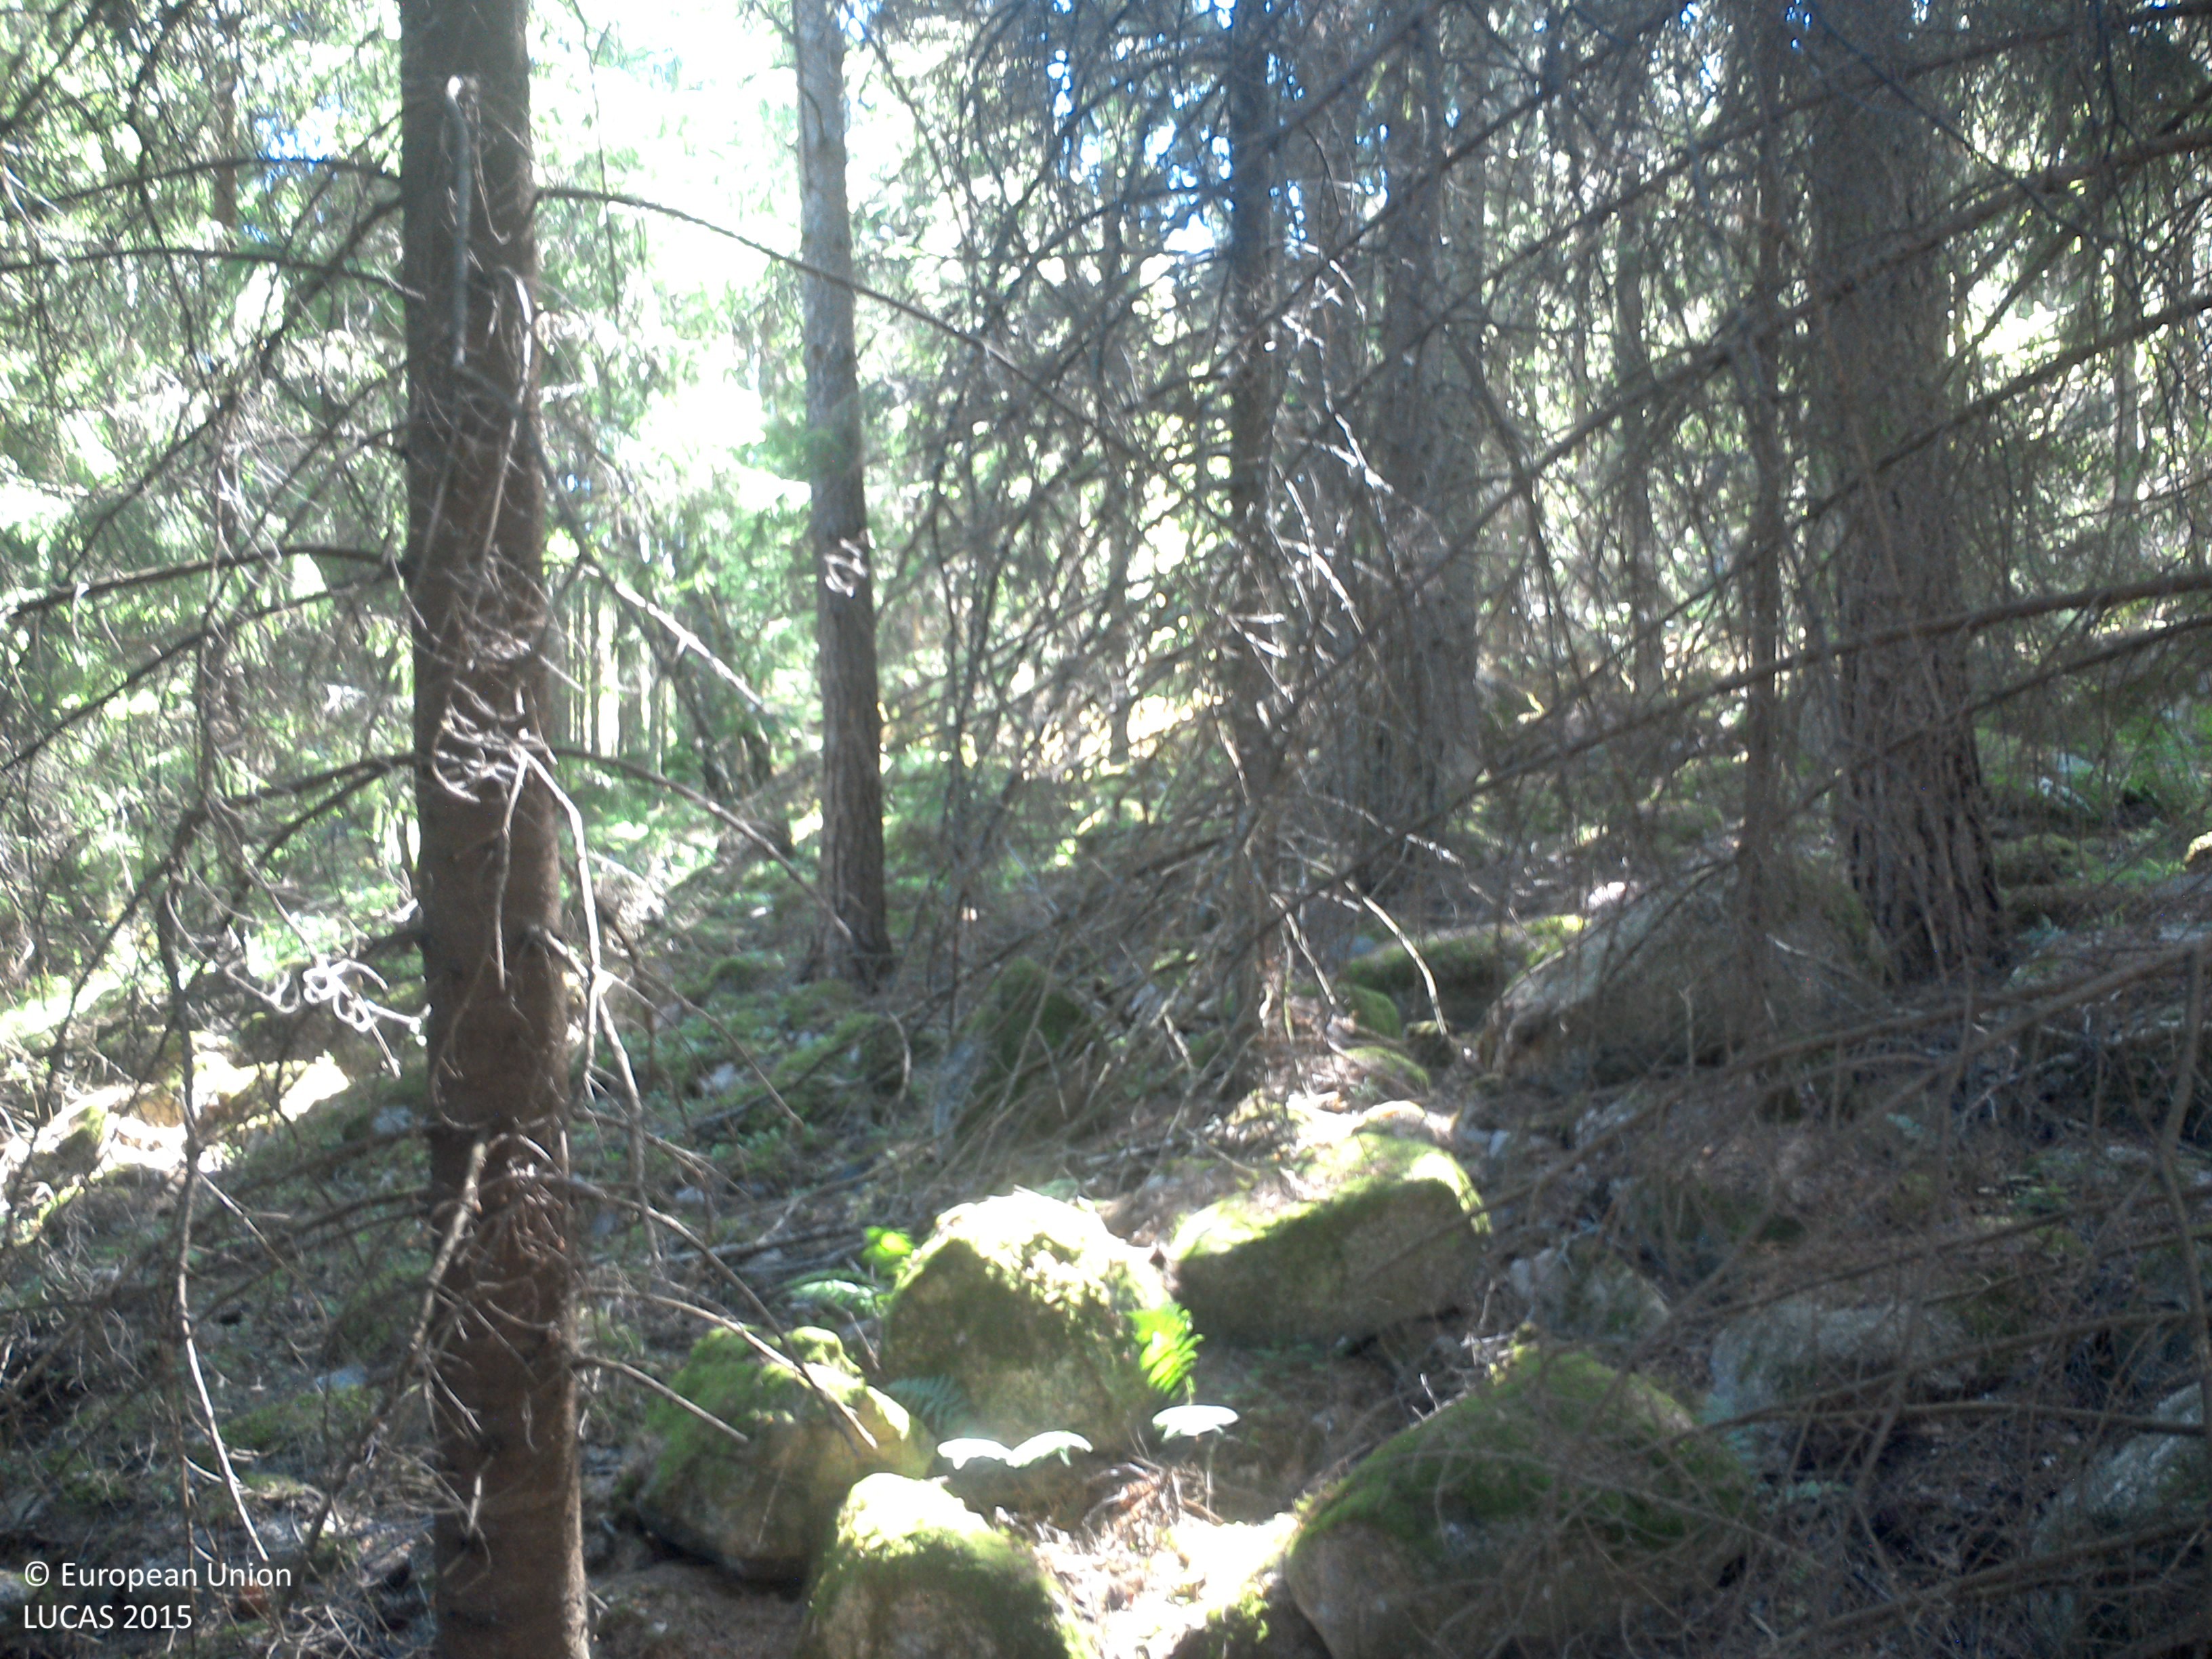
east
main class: Woodland
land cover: Spruce dominated coniferous woodland
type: boreal forest
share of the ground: > 75 %
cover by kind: coniferous forest trees 70 %, lichens and mosses 25 %, broadleaved forest trees 5 %
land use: Forestry
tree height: > 5 m
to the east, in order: Spruce dominated coniferous woodland
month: June
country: SE
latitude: 58.3131
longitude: 15.7472
